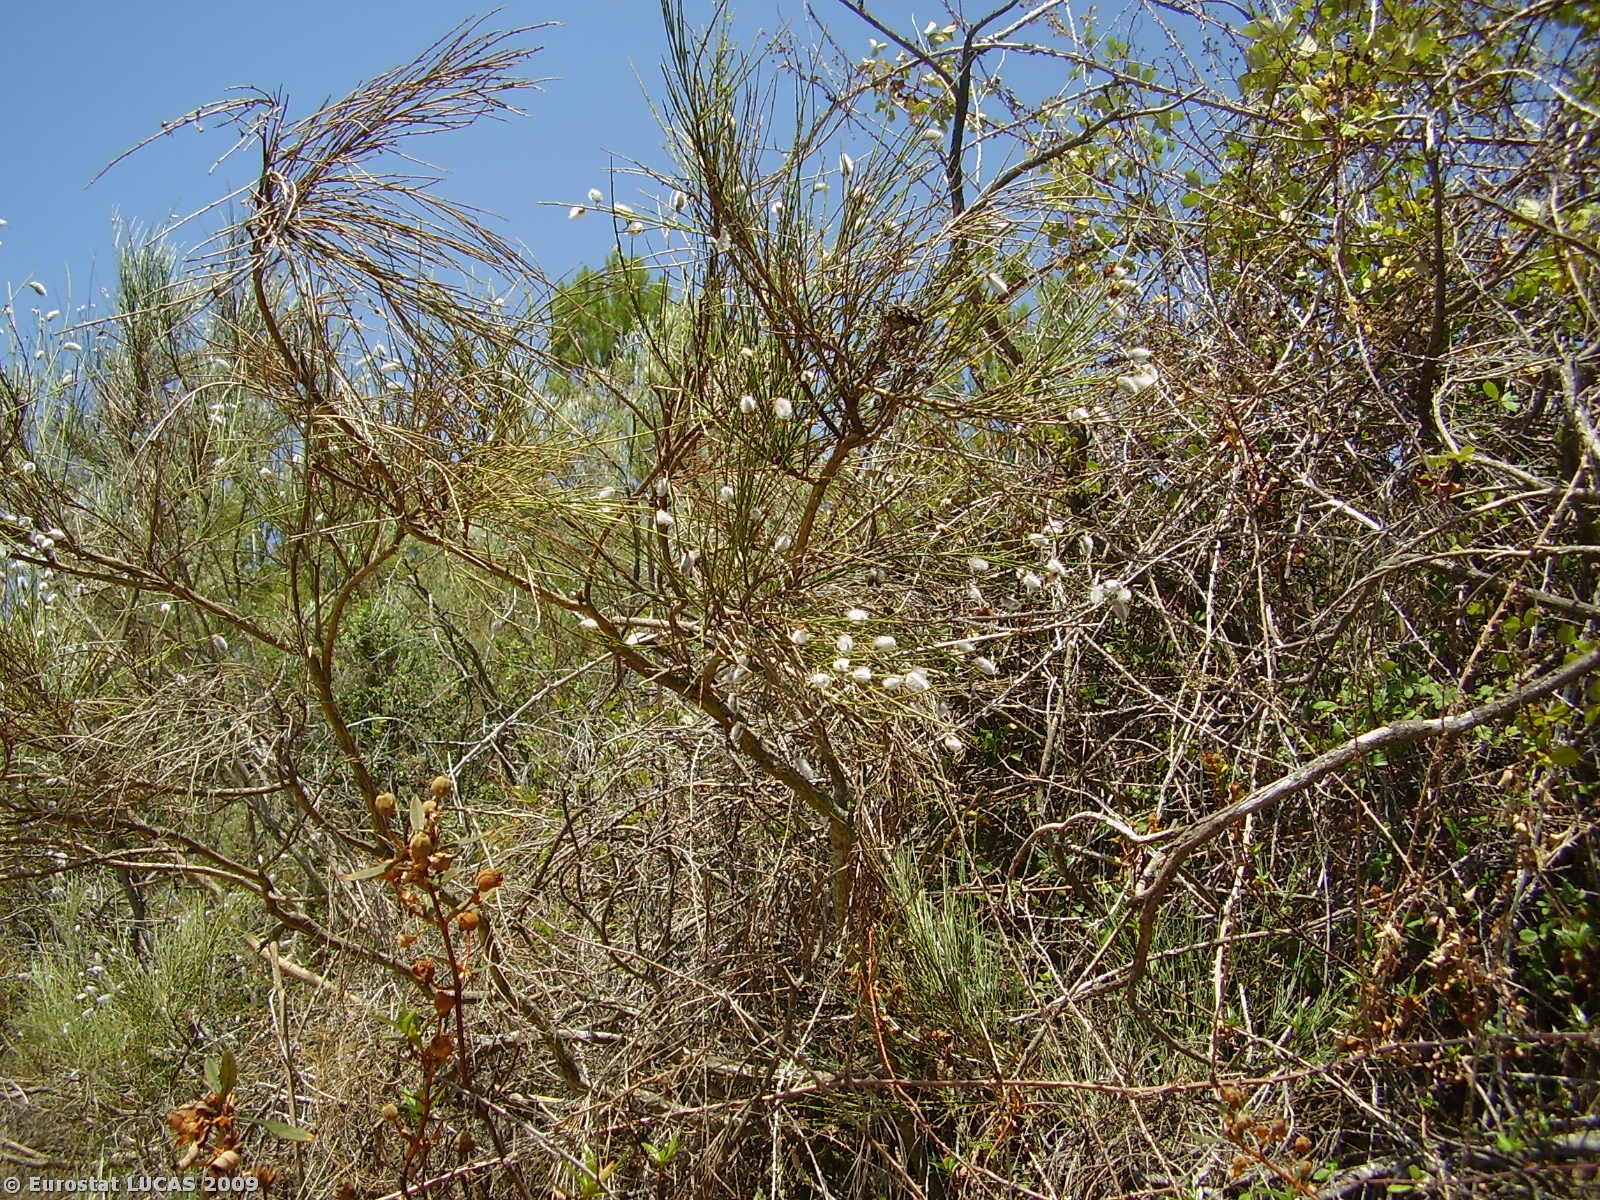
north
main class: Shrubland
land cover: Shrubland with sparse tree cover
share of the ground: 50 - 75 %
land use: Unused
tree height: > 5 m
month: July
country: PT
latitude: 41.4431
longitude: -7.3212
